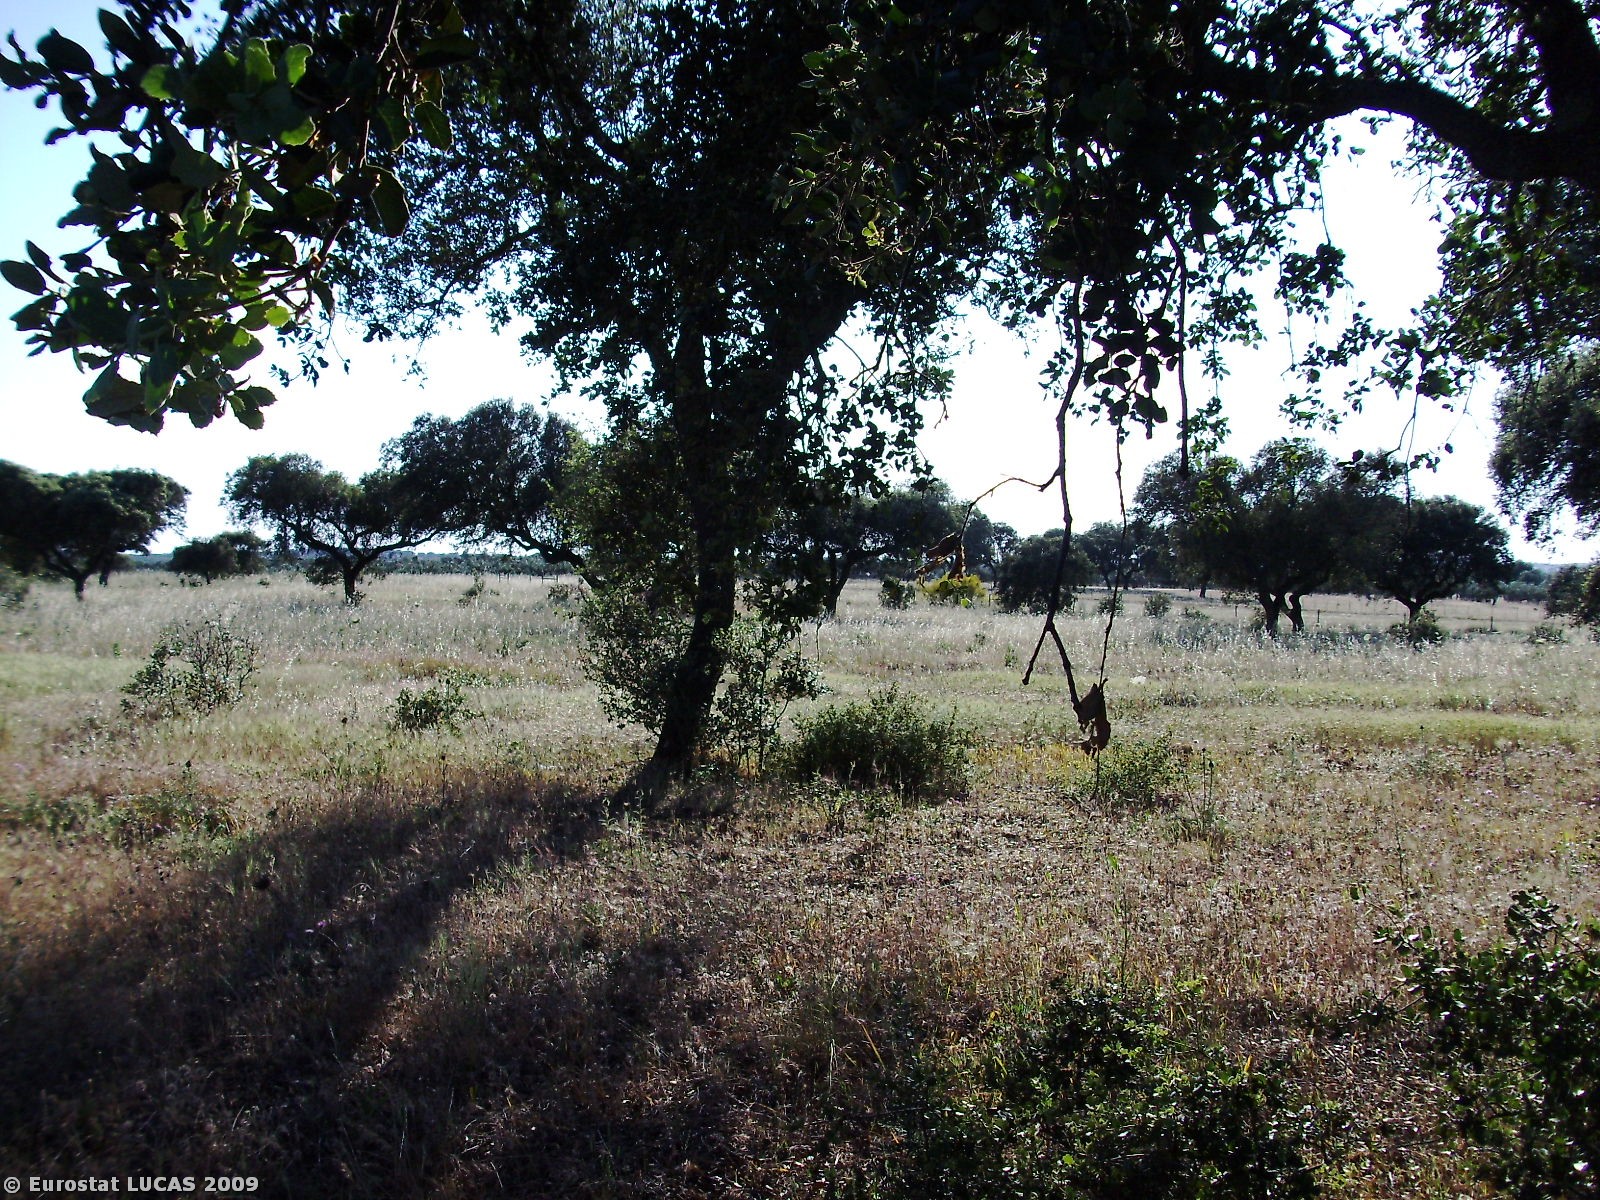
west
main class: Woodland
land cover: Broadleaved woodland
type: broadleaved evergreen forest
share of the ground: 25 - 50 %
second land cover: Spontaneously vegetated surfaces
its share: 50 - 75 %
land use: Forestry
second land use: Fallow land
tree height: > 5 m
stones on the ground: 10 - 25 %
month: May
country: PT
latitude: 38.9870
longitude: -7.3391
